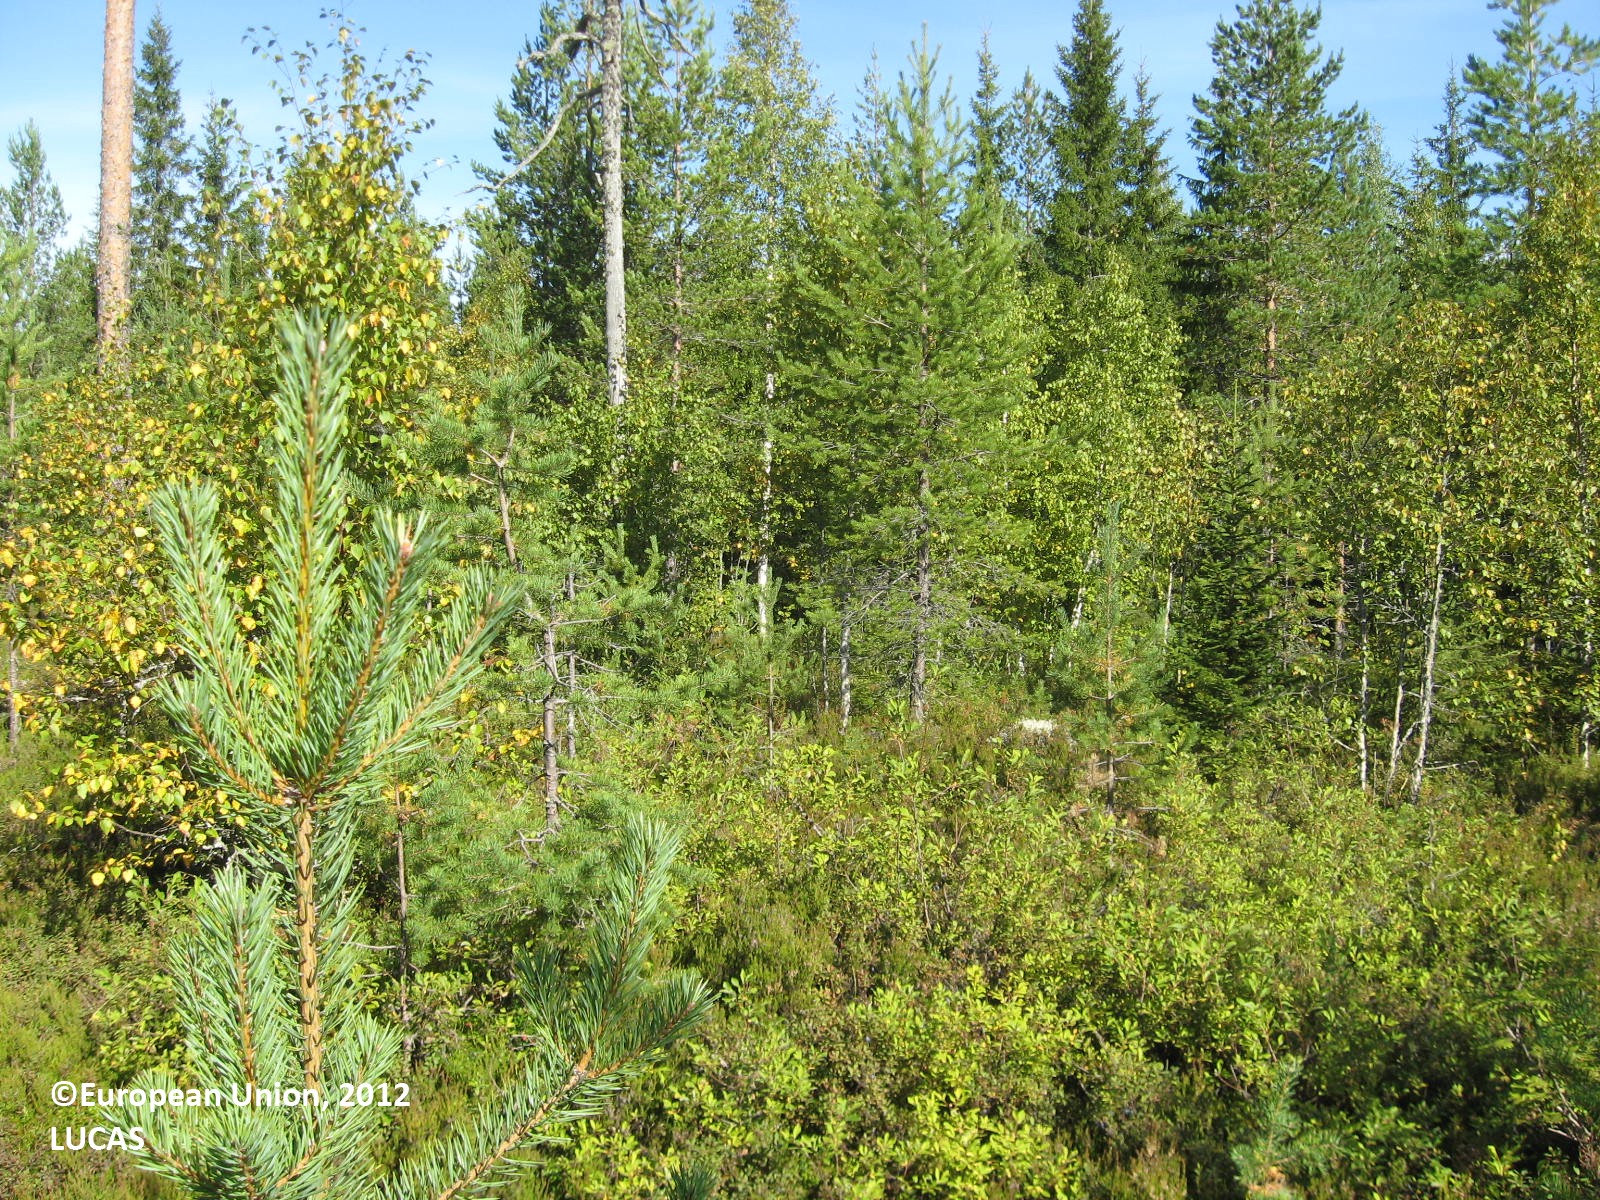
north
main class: Woodland
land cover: Other mixed woodland
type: boreal forest
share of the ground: 50 - 75 %
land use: Forestry
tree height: < 5 m
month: August
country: FI
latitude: 63.7689
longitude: 29.3400
